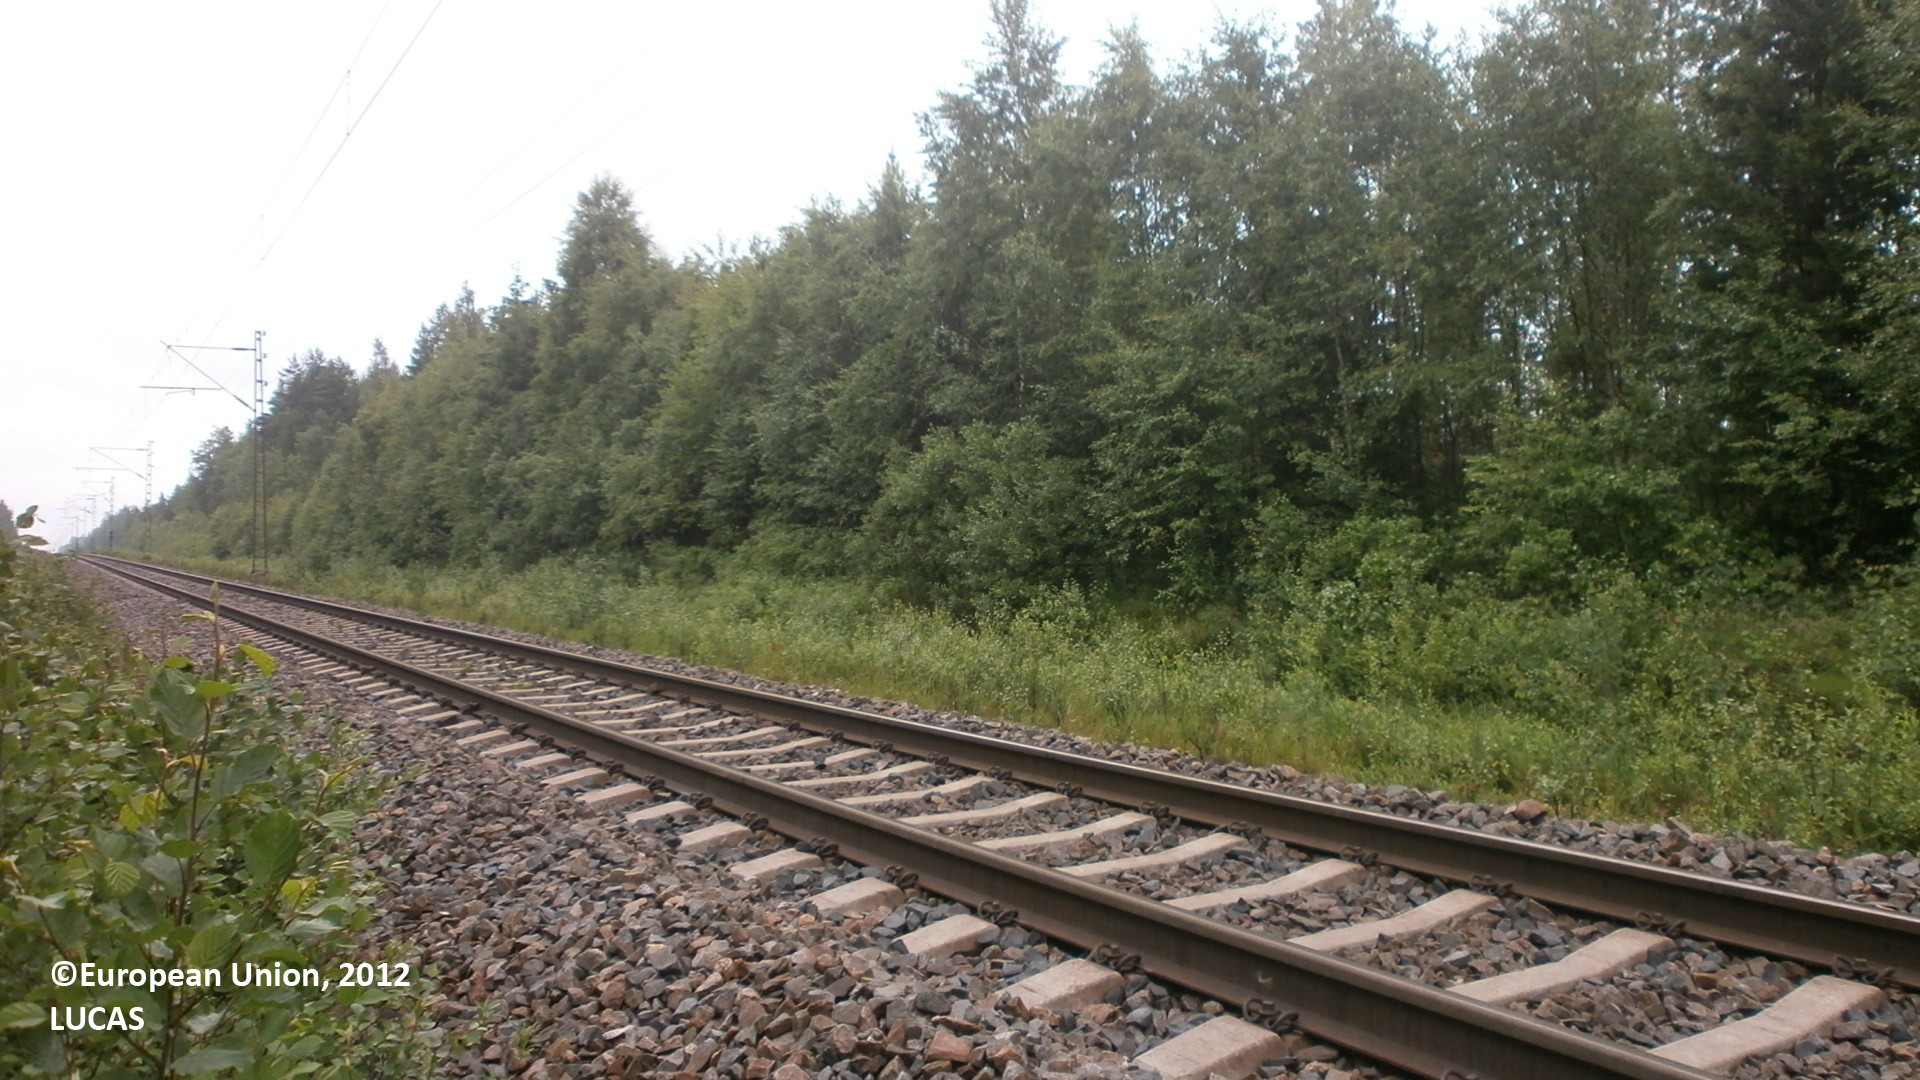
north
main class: Artificial land
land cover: Non built-up linear features
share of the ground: 50 - 75 %
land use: Railway transport
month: July
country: FI
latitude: 64.3648
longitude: 24.9751
